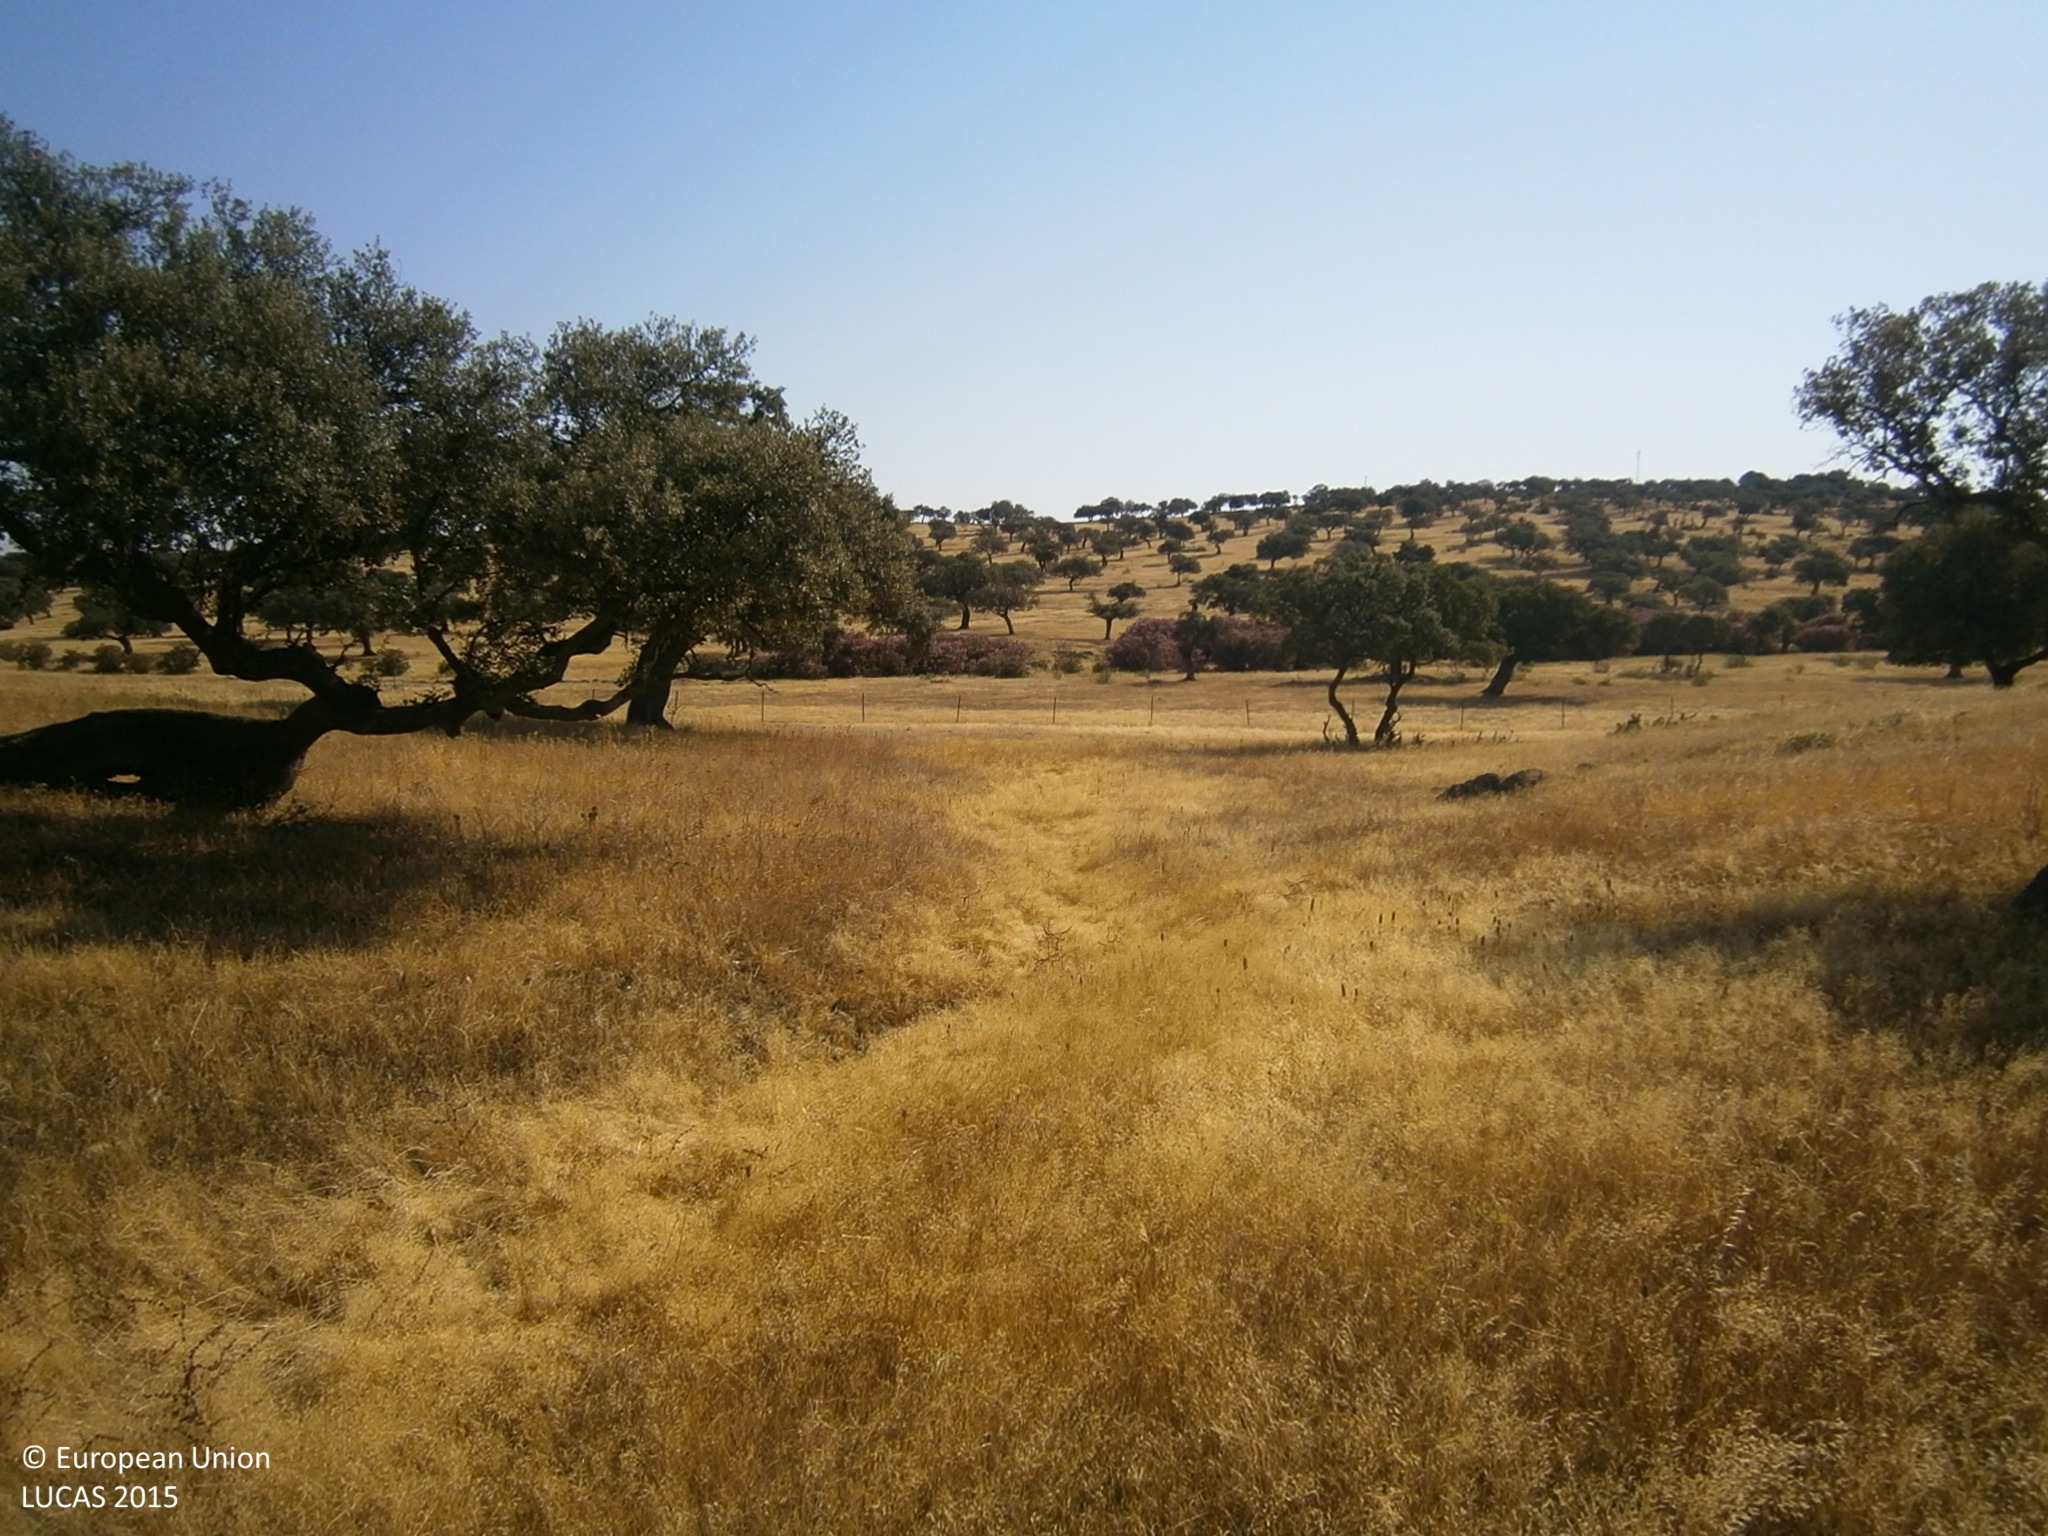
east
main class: Grassland
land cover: Grassland with sparse tree/shrub cover
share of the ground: > 75 %
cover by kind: herbaceous plants 90 %, broadleaved forest trees 5 %, shrubs 5 %
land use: Agriculture (excluding fallow land and kitchen gardens)
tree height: > 5 m
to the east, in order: Grassland with sparse tree/shrub cover; Fences; Grassland with sparse tree/shrub cover
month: June
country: ES
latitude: 38.5997
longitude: -6.7202
